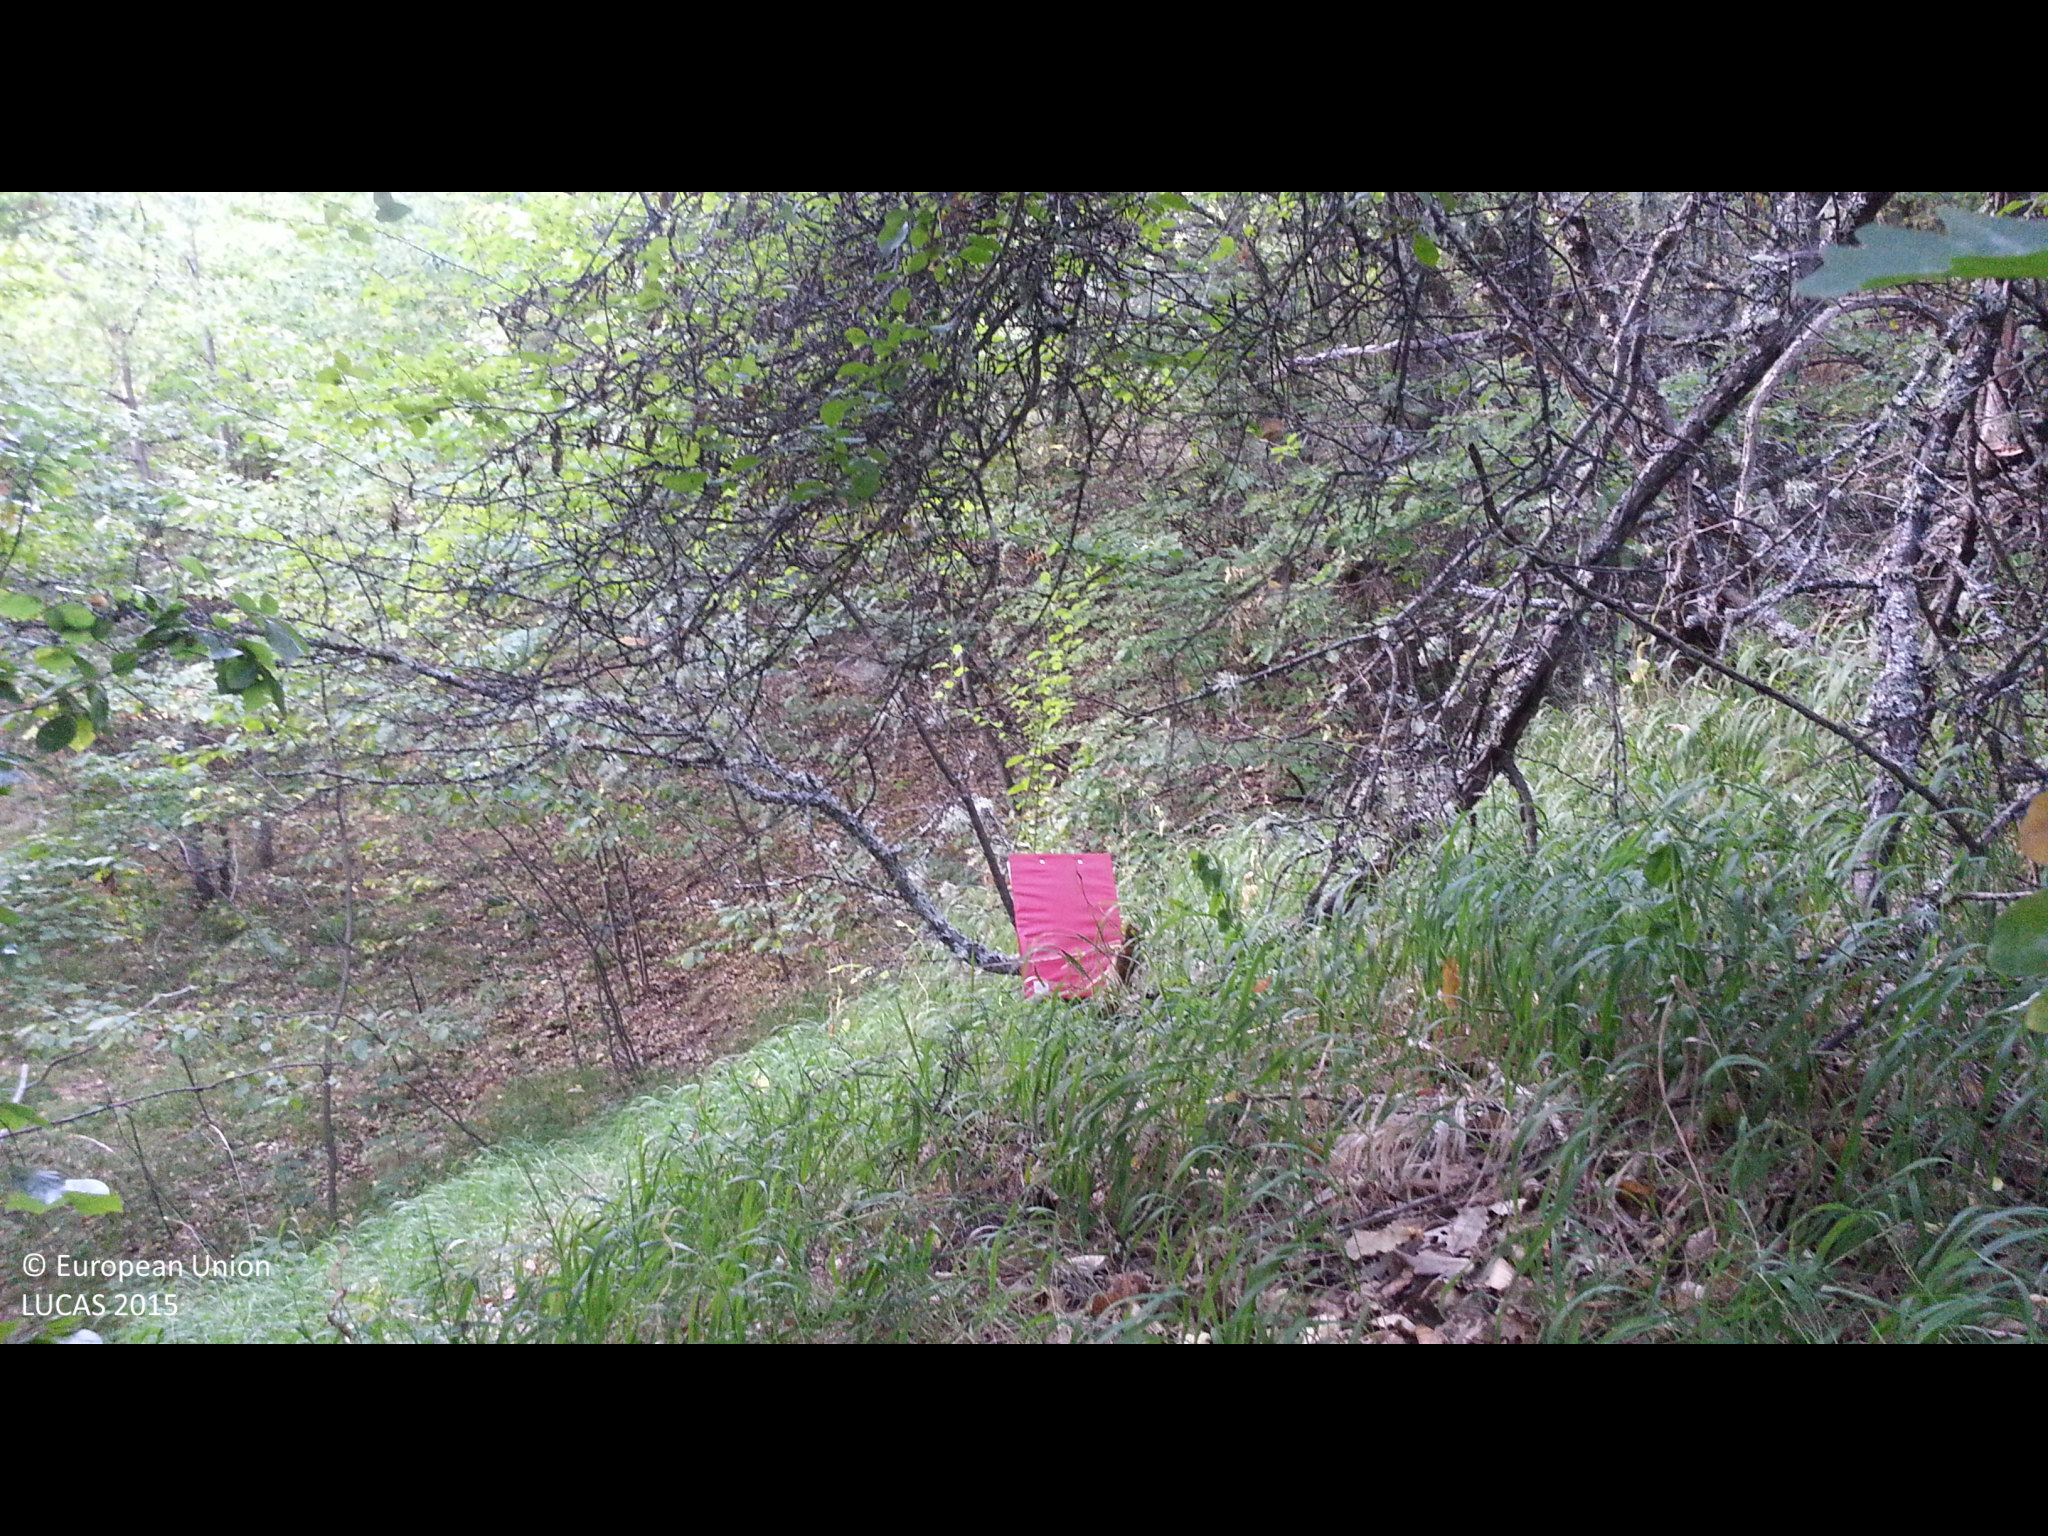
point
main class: Woodland
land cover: Broadleaved woodland
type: mesophytic deciduous forest
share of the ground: > 75 %
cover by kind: broadleaved forest trees 85 %, herbaceous plants 10 %, shrubs 5 %
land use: Forestry
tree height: > 5 m
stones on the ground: < 10 %
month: September
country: BG
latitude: 42.3287
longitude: 22.5319
